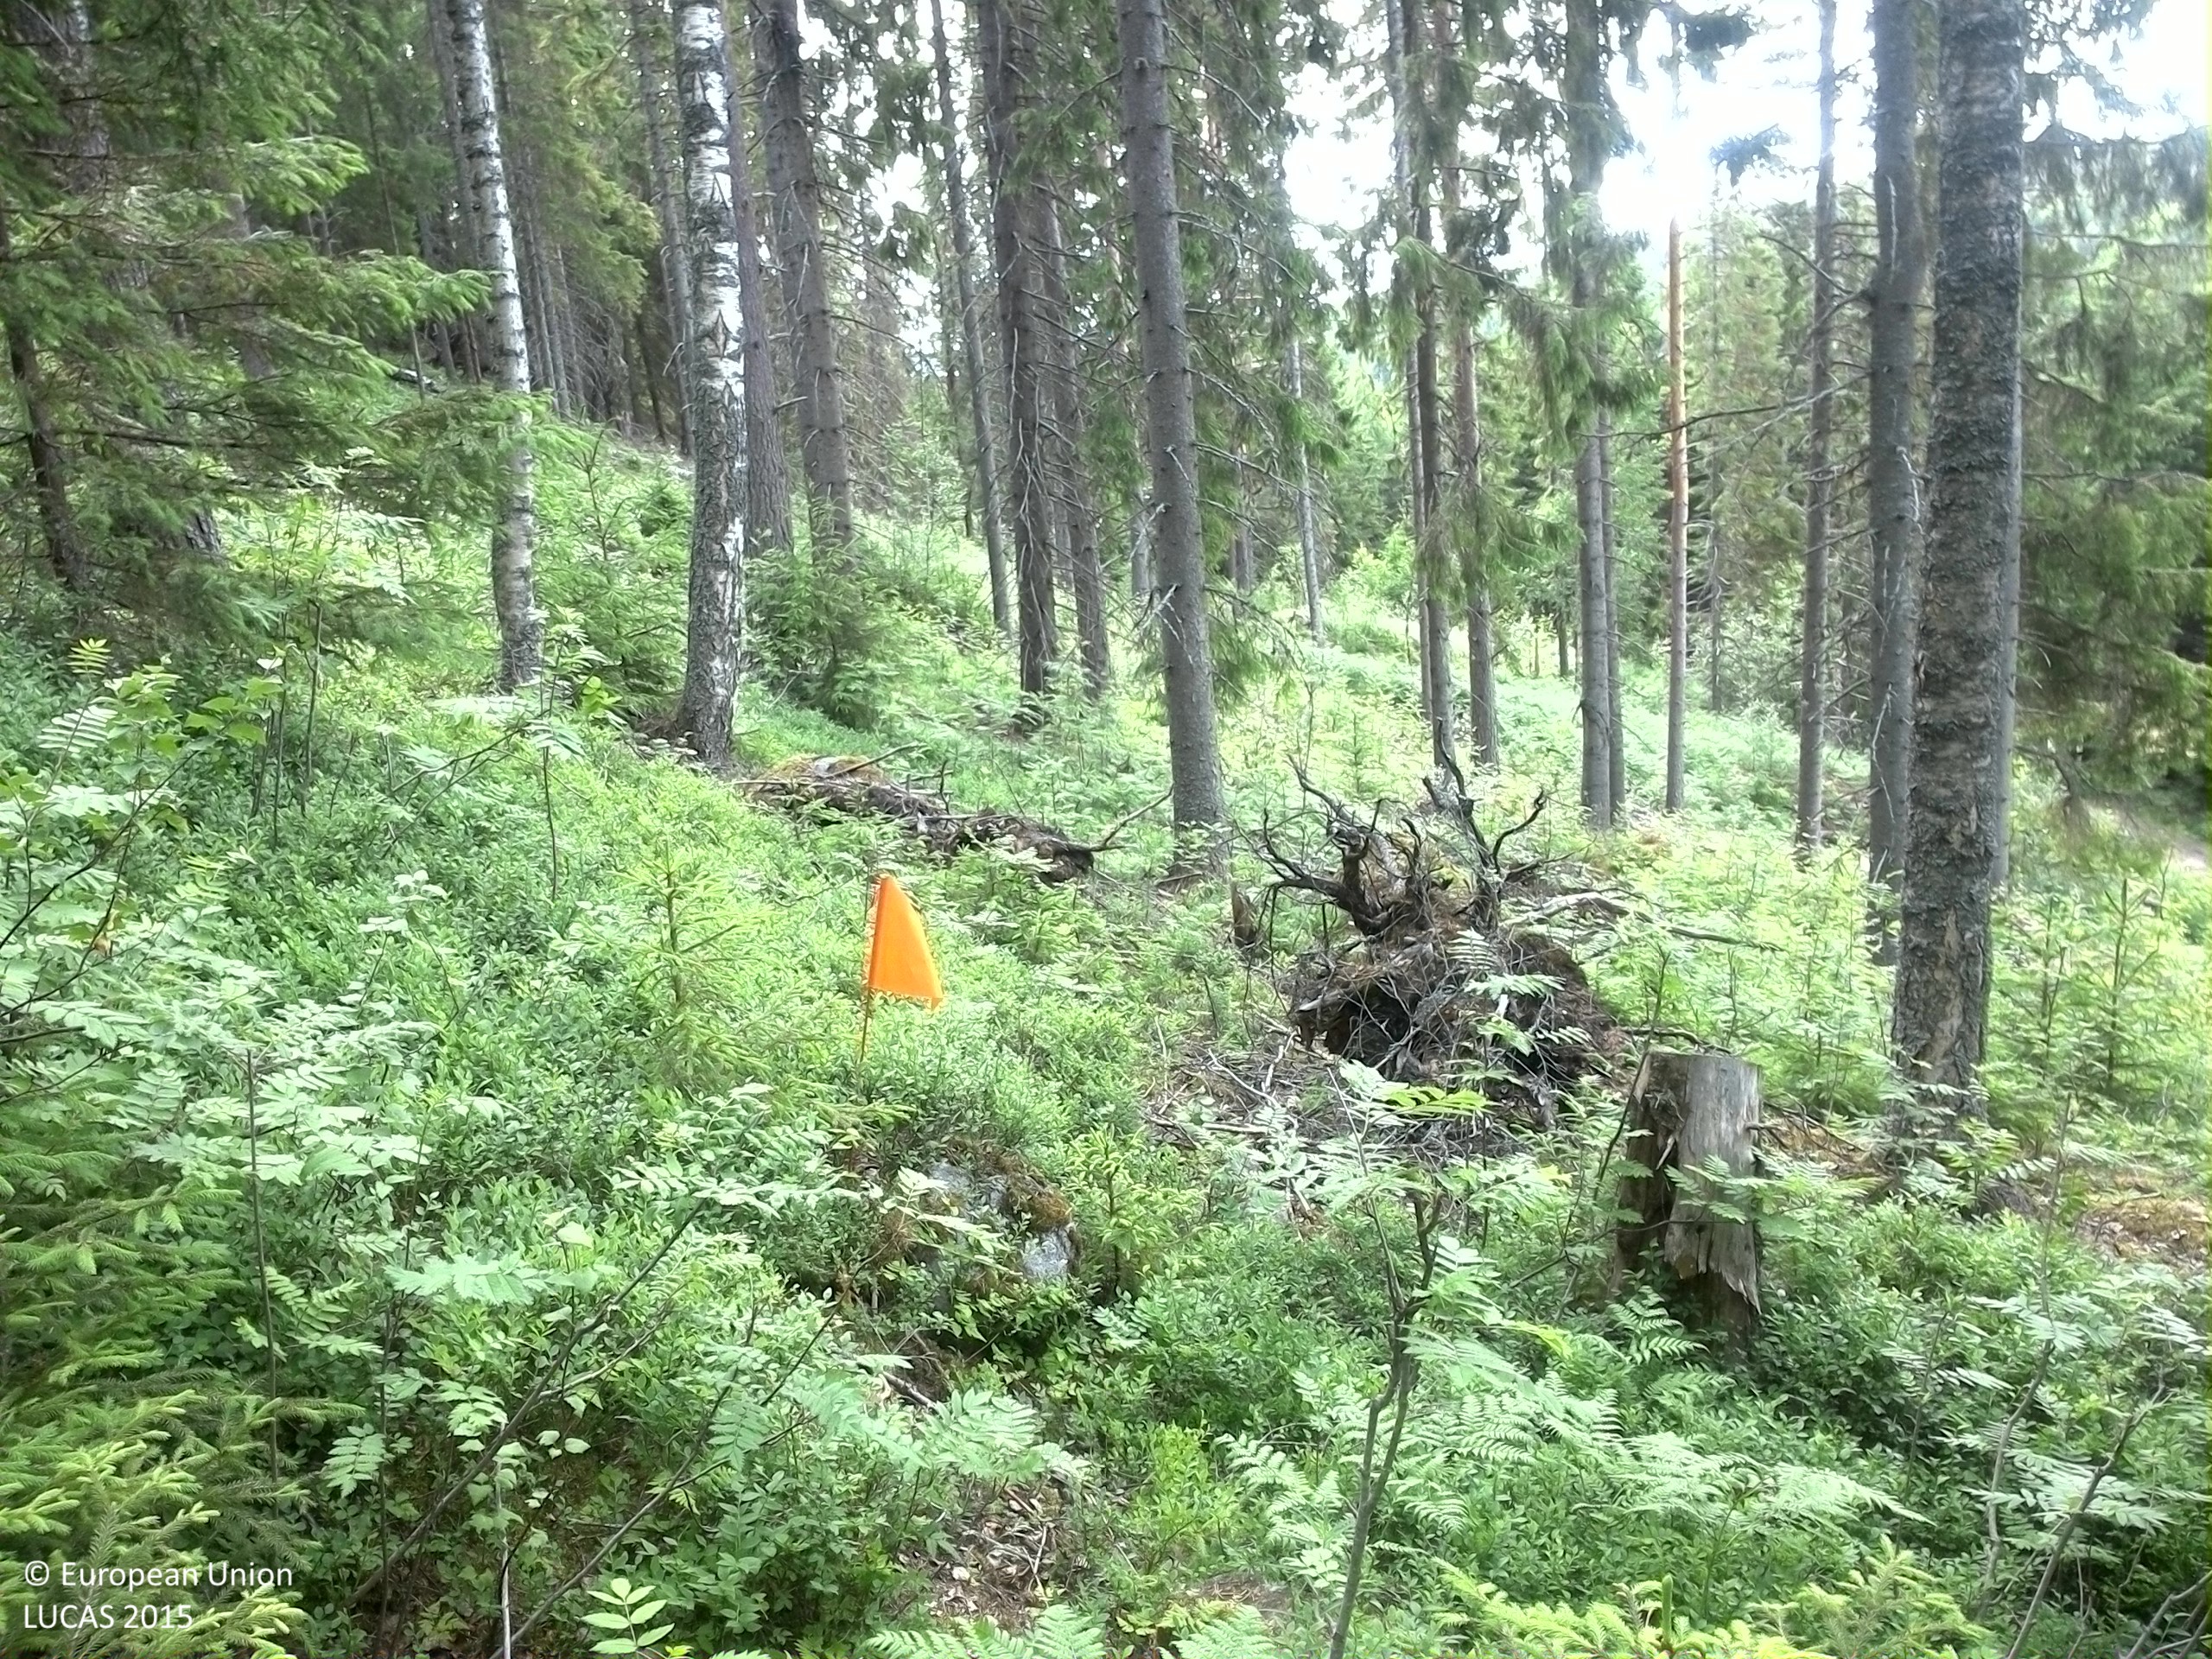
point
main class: Woodland
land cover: Spruce dominated mixed woodland
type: boreal forest
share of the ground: 50 - 75 %
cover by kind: shrubs 45 %, coniferous forest trees 40 %, broadleaved forest trees 15 %
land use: Forestry
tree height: > 5 m
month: June
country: SE
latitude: 62.8445
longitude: 17.8148
